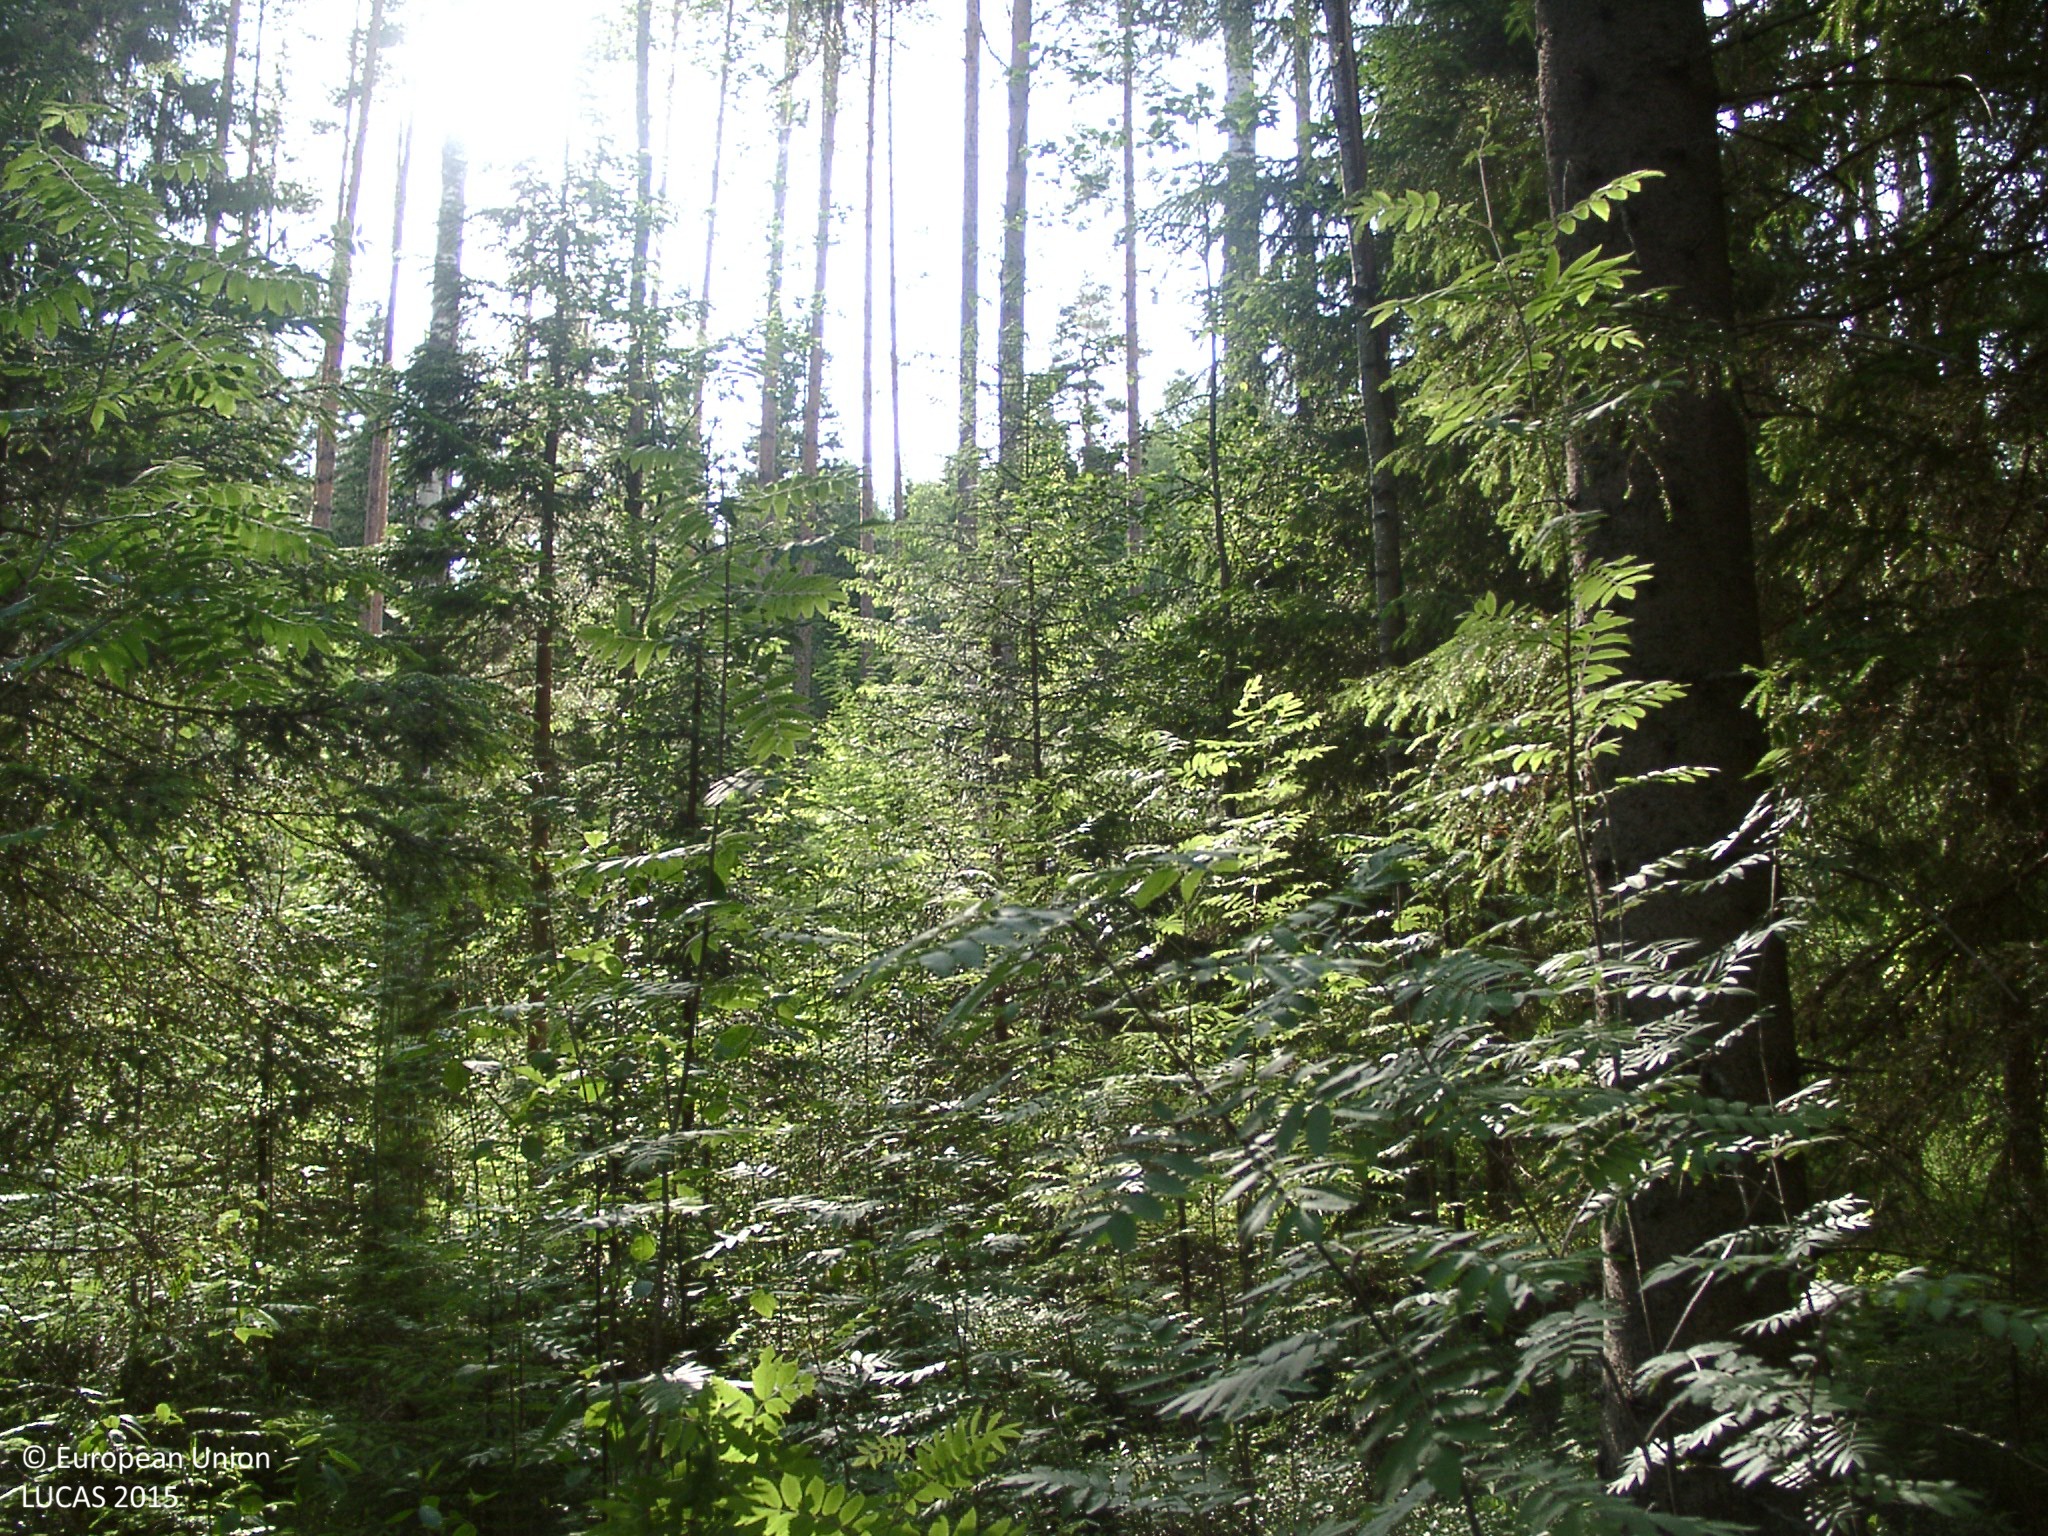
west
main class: Woodland
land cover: Other mixed woodland
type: boreal forest
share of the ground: 50 - 75 %
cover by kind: coniferous forest trees 35 %, broadleaved forest trees 35 %, shrubs 30 %
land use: Semi-natural and natural areas not in use
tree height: > 5 m
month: July
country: FI
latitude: 62.0180
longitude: 25.3784
